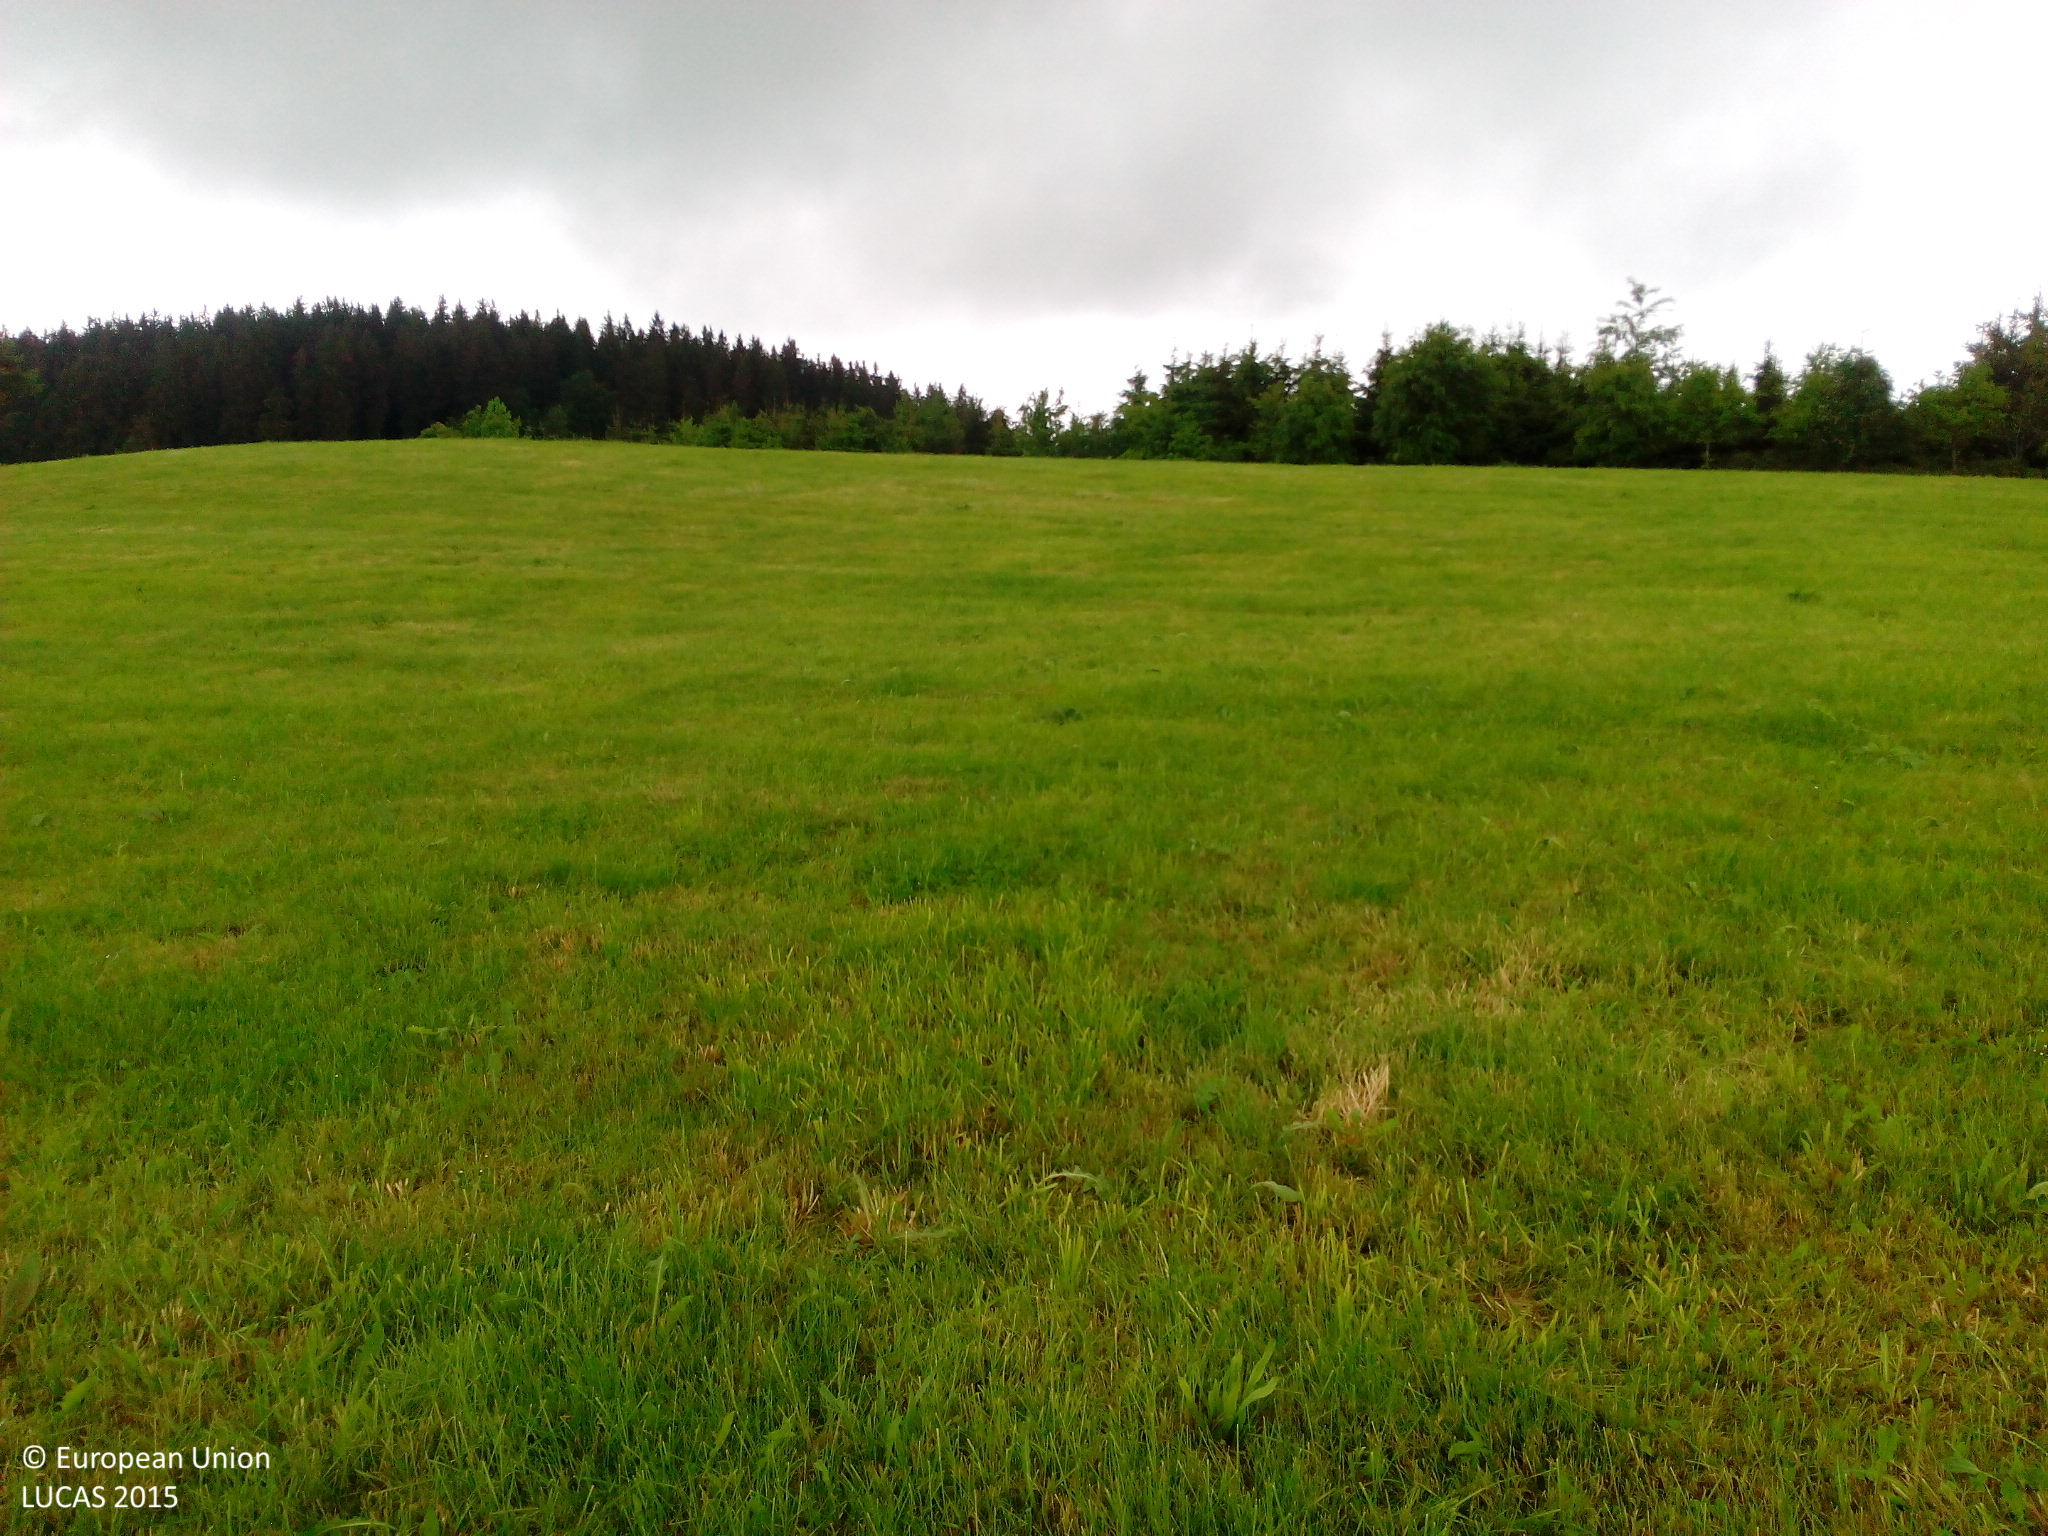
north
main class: Grassland
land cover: Grassland without tree/shrub cover
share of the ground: > 75 %
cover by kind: herbaceous plants 100 %
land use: Agriculture (excluding fallow land and kitchen gardens)
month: May
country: DE
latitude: 47.7556
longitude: 9.9334
